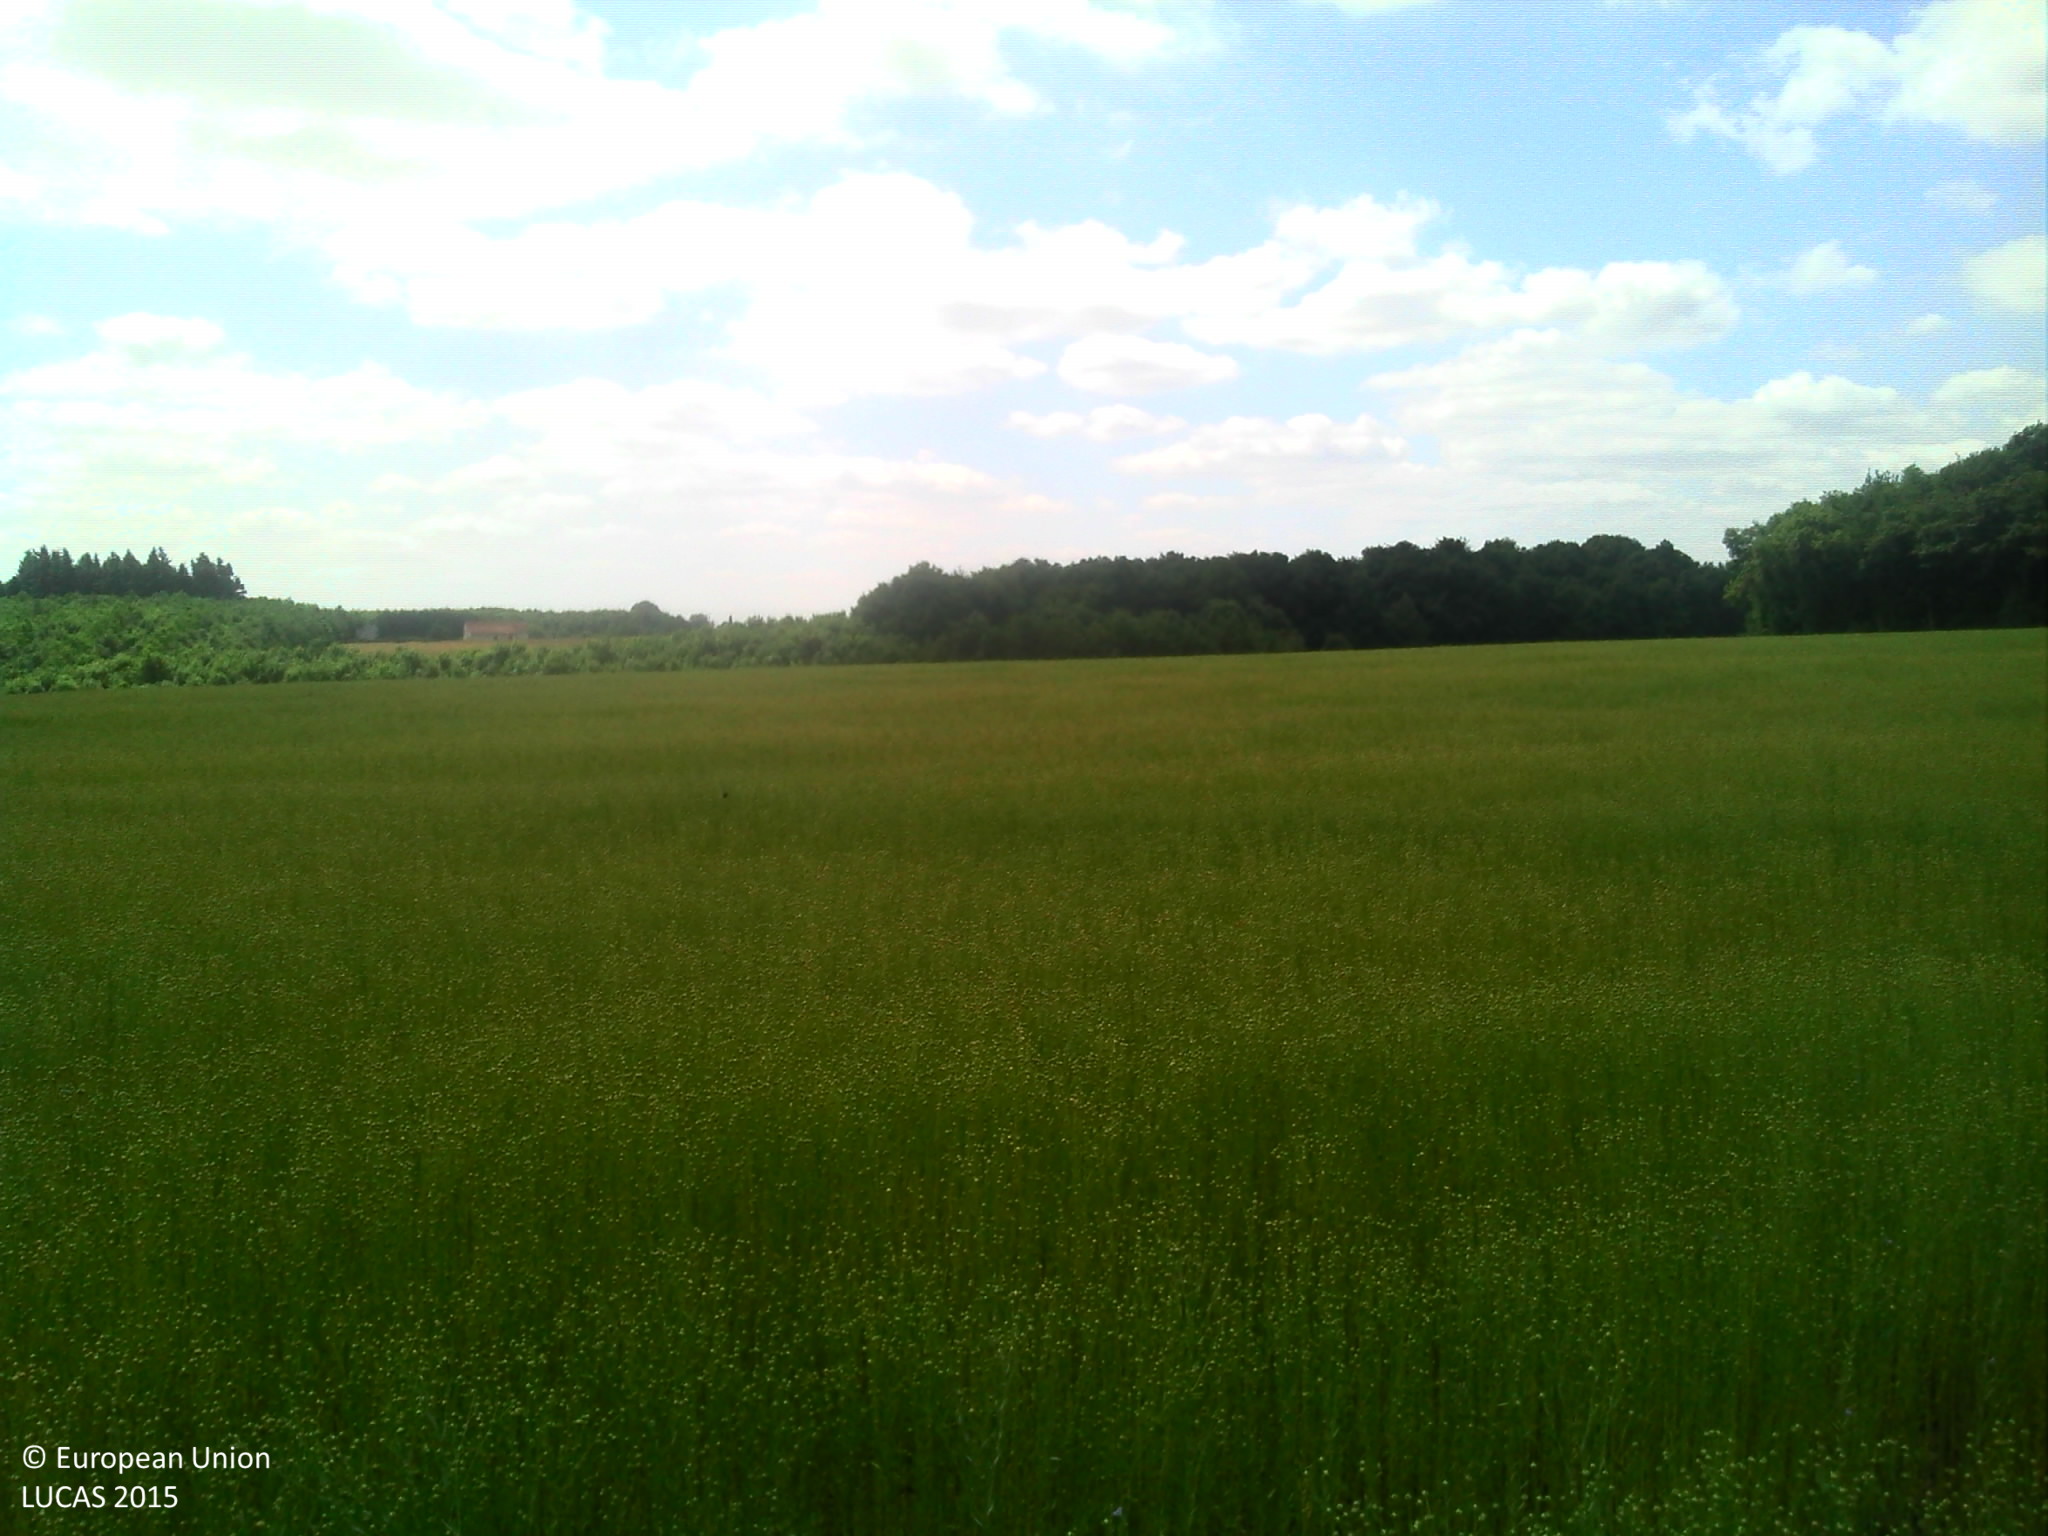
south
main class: Cropland
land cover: Other fibre and oleaginous crops
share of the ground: > 75 %
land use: Agriculture (excluding fallow land and kitchen gardens)
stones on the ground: 10 - 25 %
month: July
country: FR
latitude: 48.7210
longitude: 0.7472
